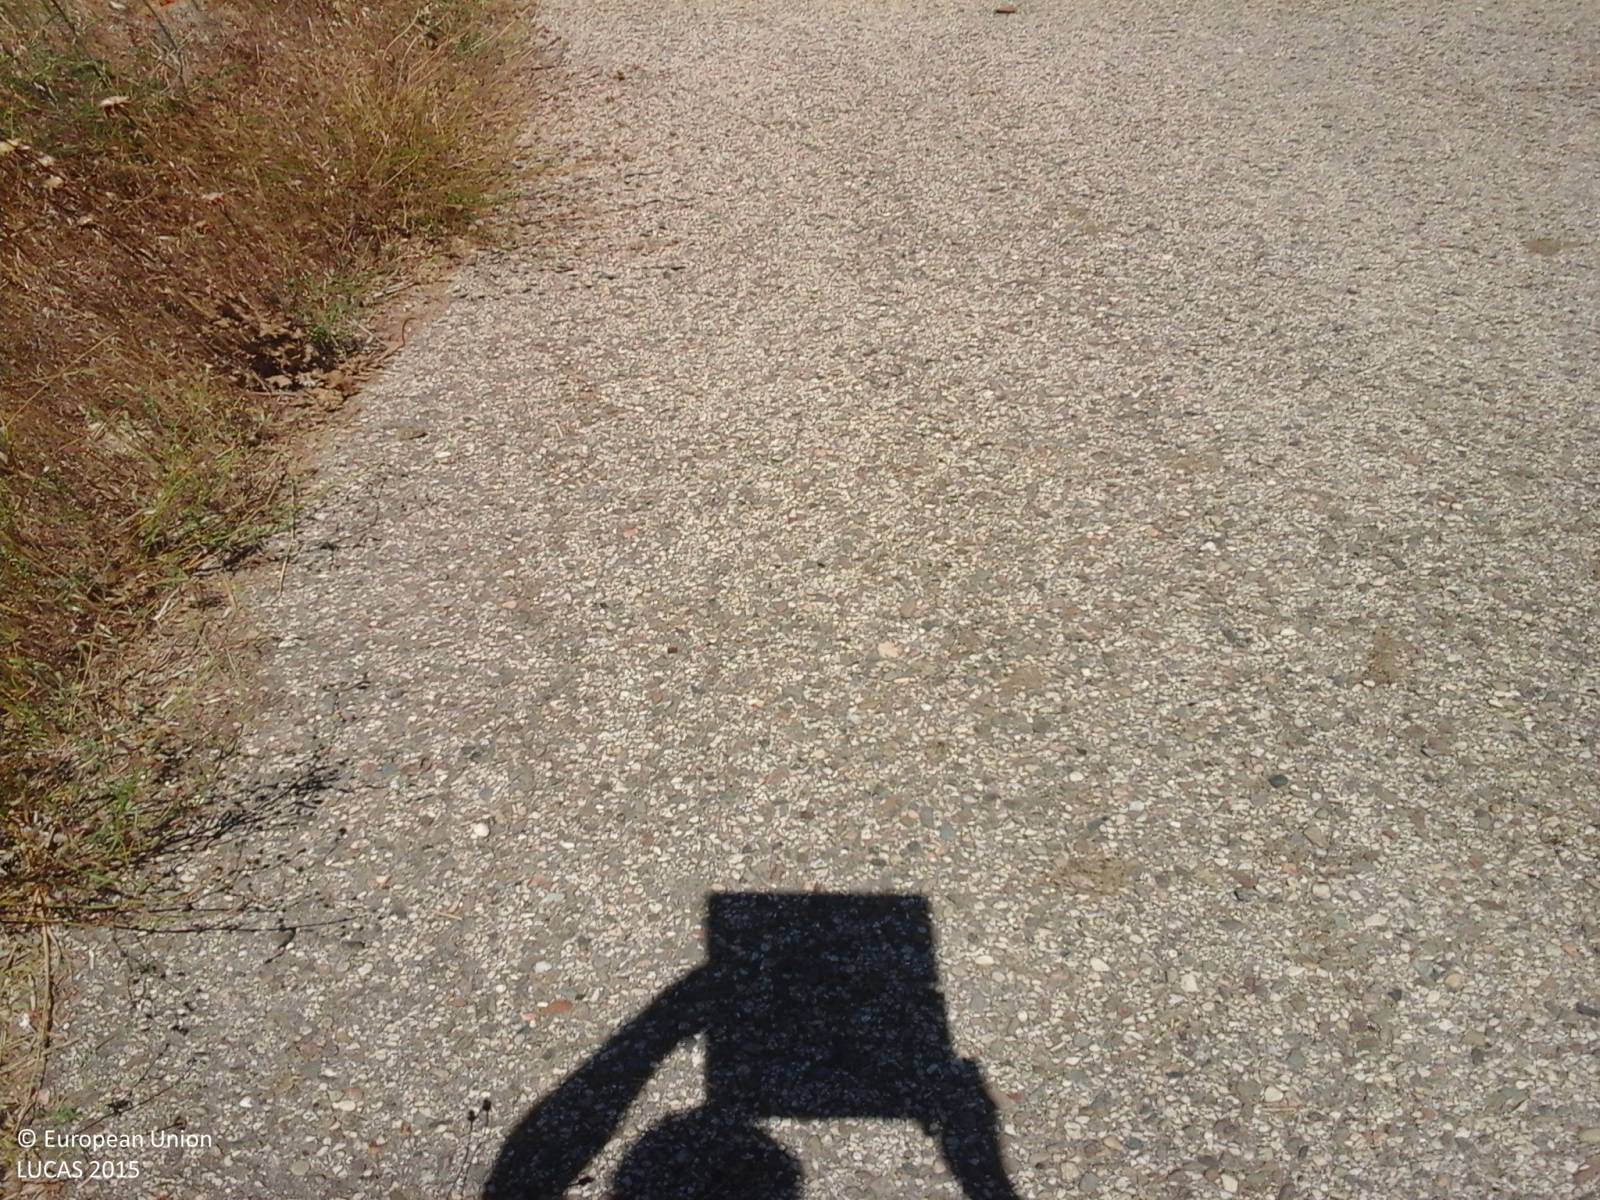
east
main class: Cropland
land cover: Maize
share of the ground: > 75 %
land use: Agriculture (excluding fallow land and kitchen gardens)
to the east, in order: Maize; Managed hedges; Tracks; Grass margins; Temporary grasslands; Fences; Temporary grasslands
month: June
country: IT
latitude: 39.5175
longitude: 8.8090
